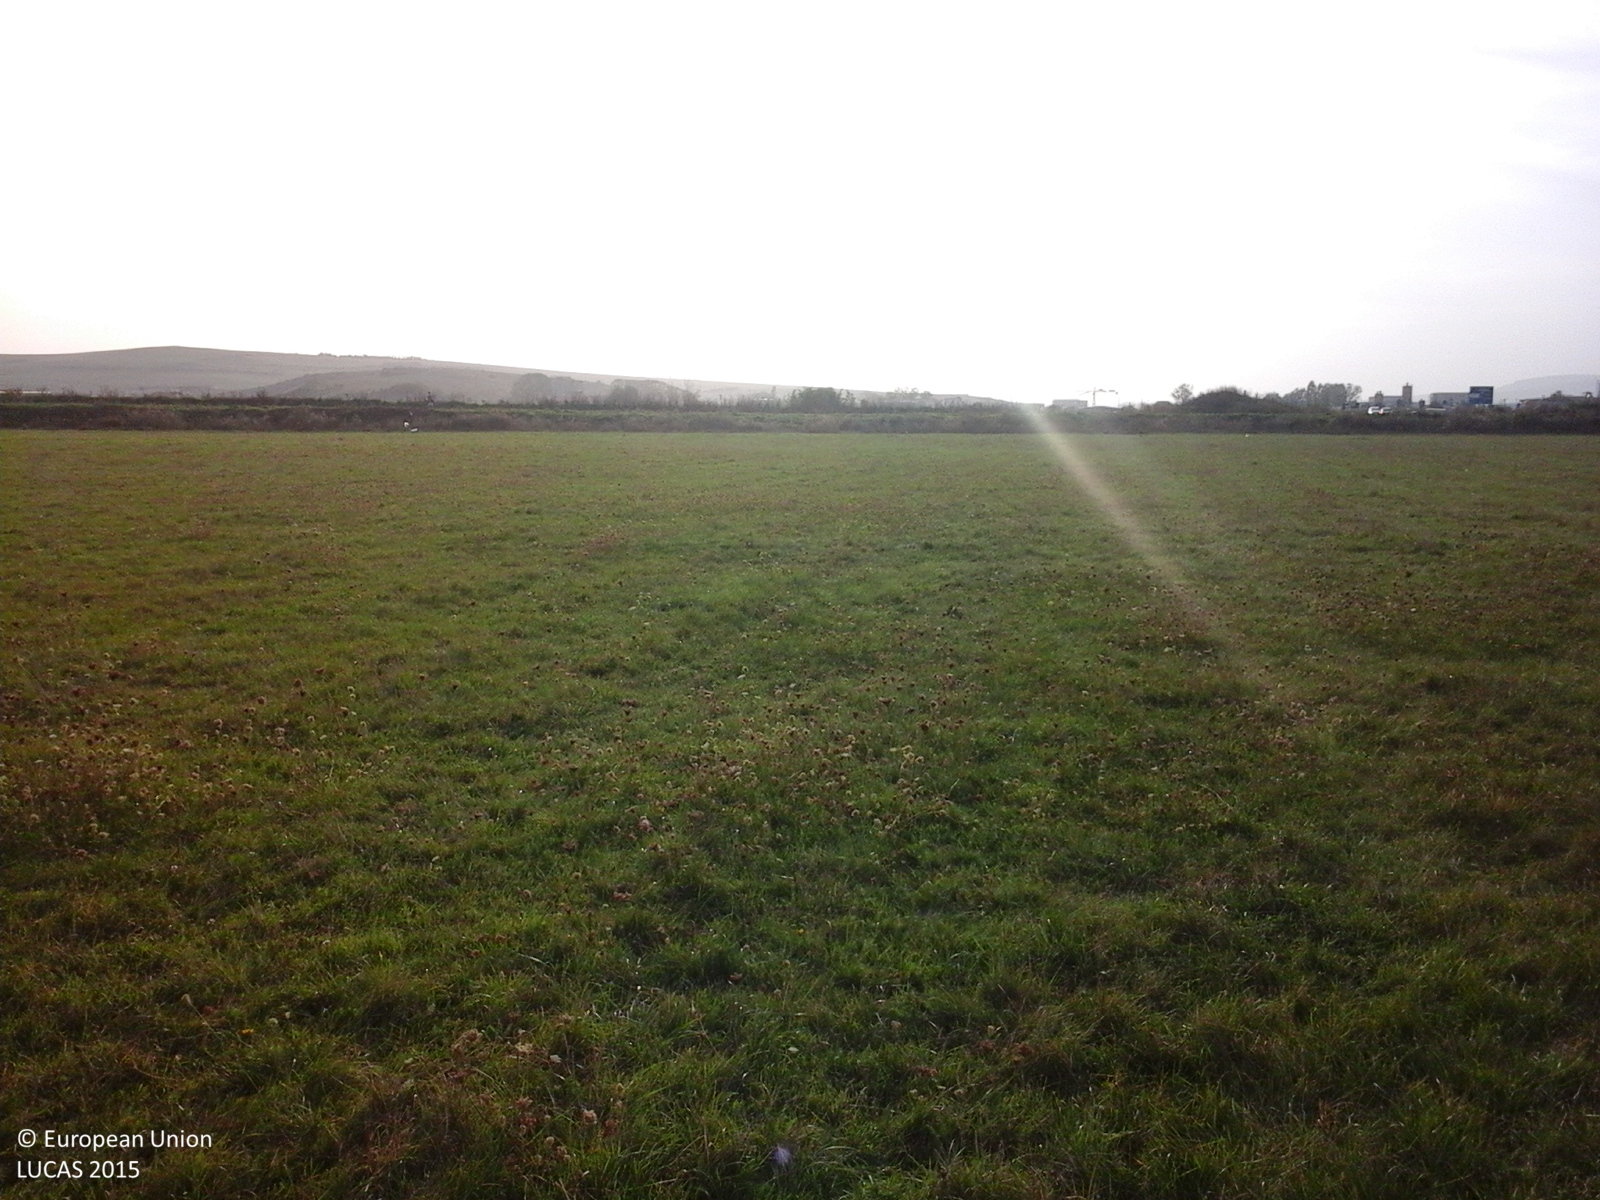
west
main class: Grassland
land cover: Grassland without tree/shrub cover
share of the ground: > 75 %
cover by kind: herbaceous plants 100 %
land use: Agriculture (excluding fallow land and kitchen gardens)
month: September
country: RO
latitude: 46.7782
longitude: 23.7073
